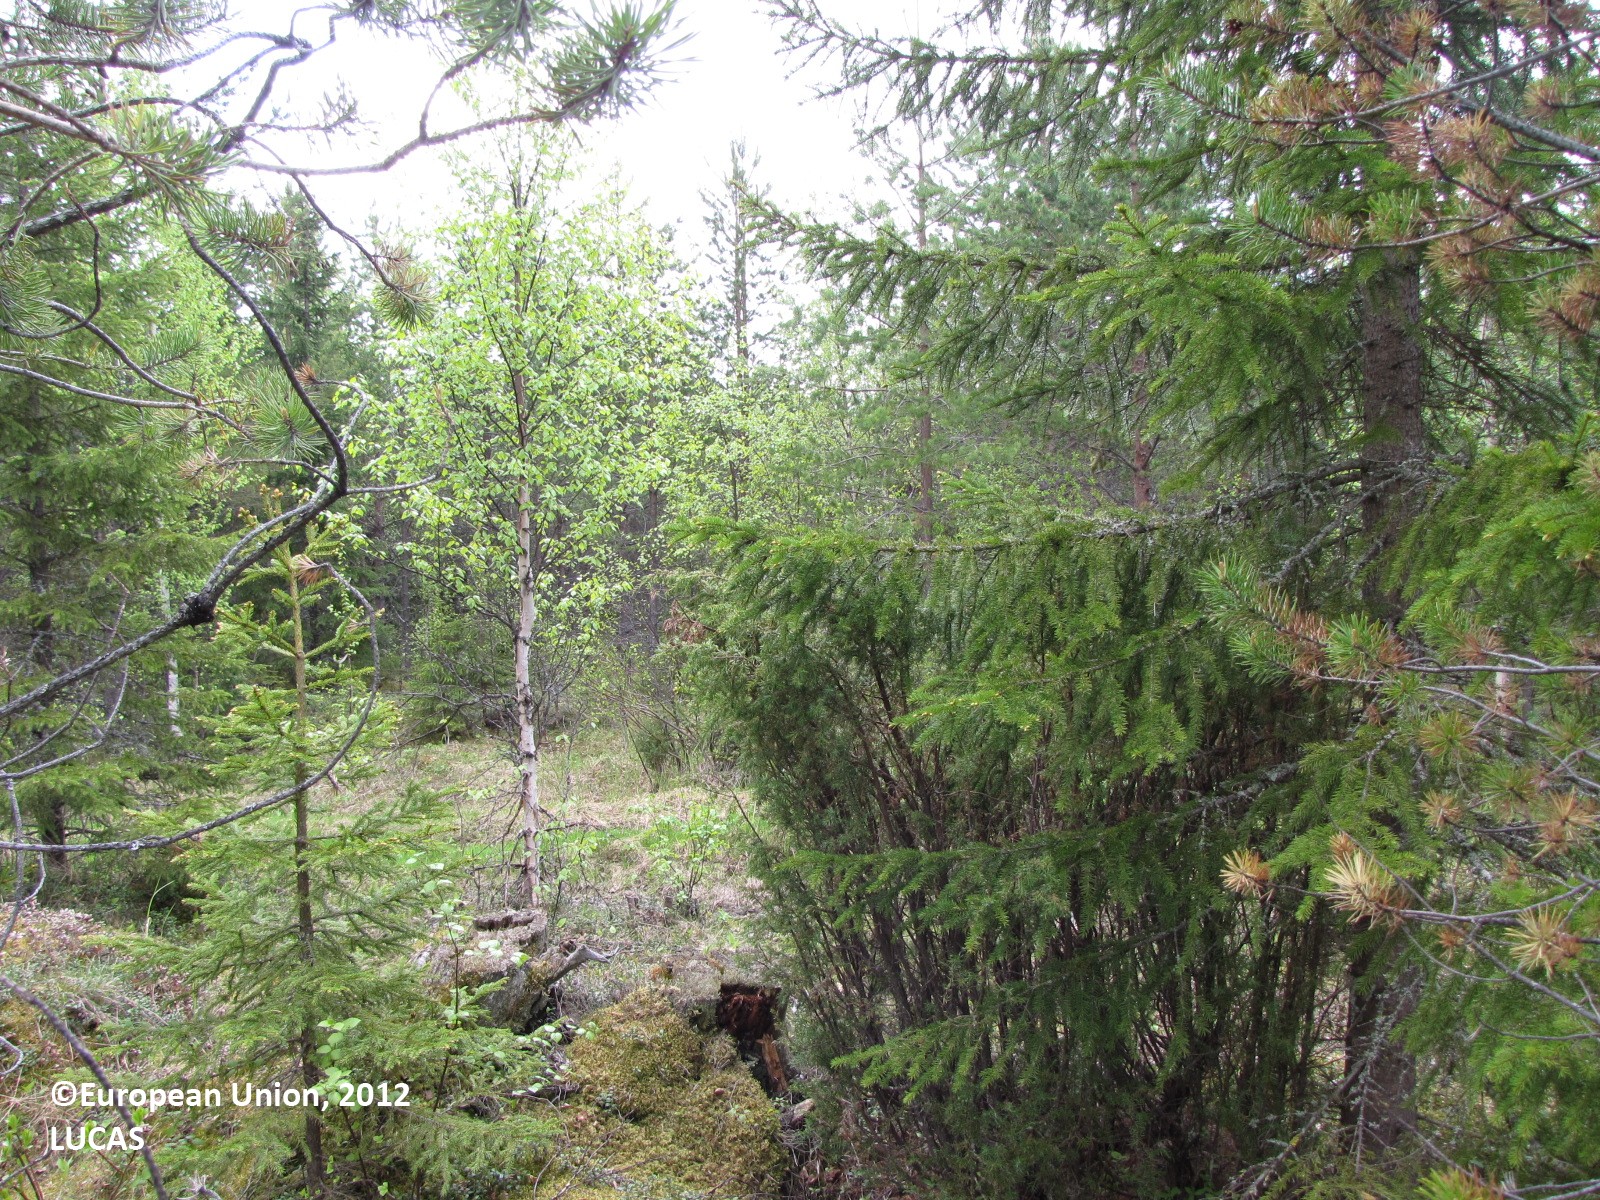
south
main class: Woodland
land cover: Other coniferous woodland
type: boreal forest
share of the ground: 25 - 50 %
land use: Forestry
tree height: > 5 m
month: June
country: FI
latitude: 65.8525
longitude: 24.6680
